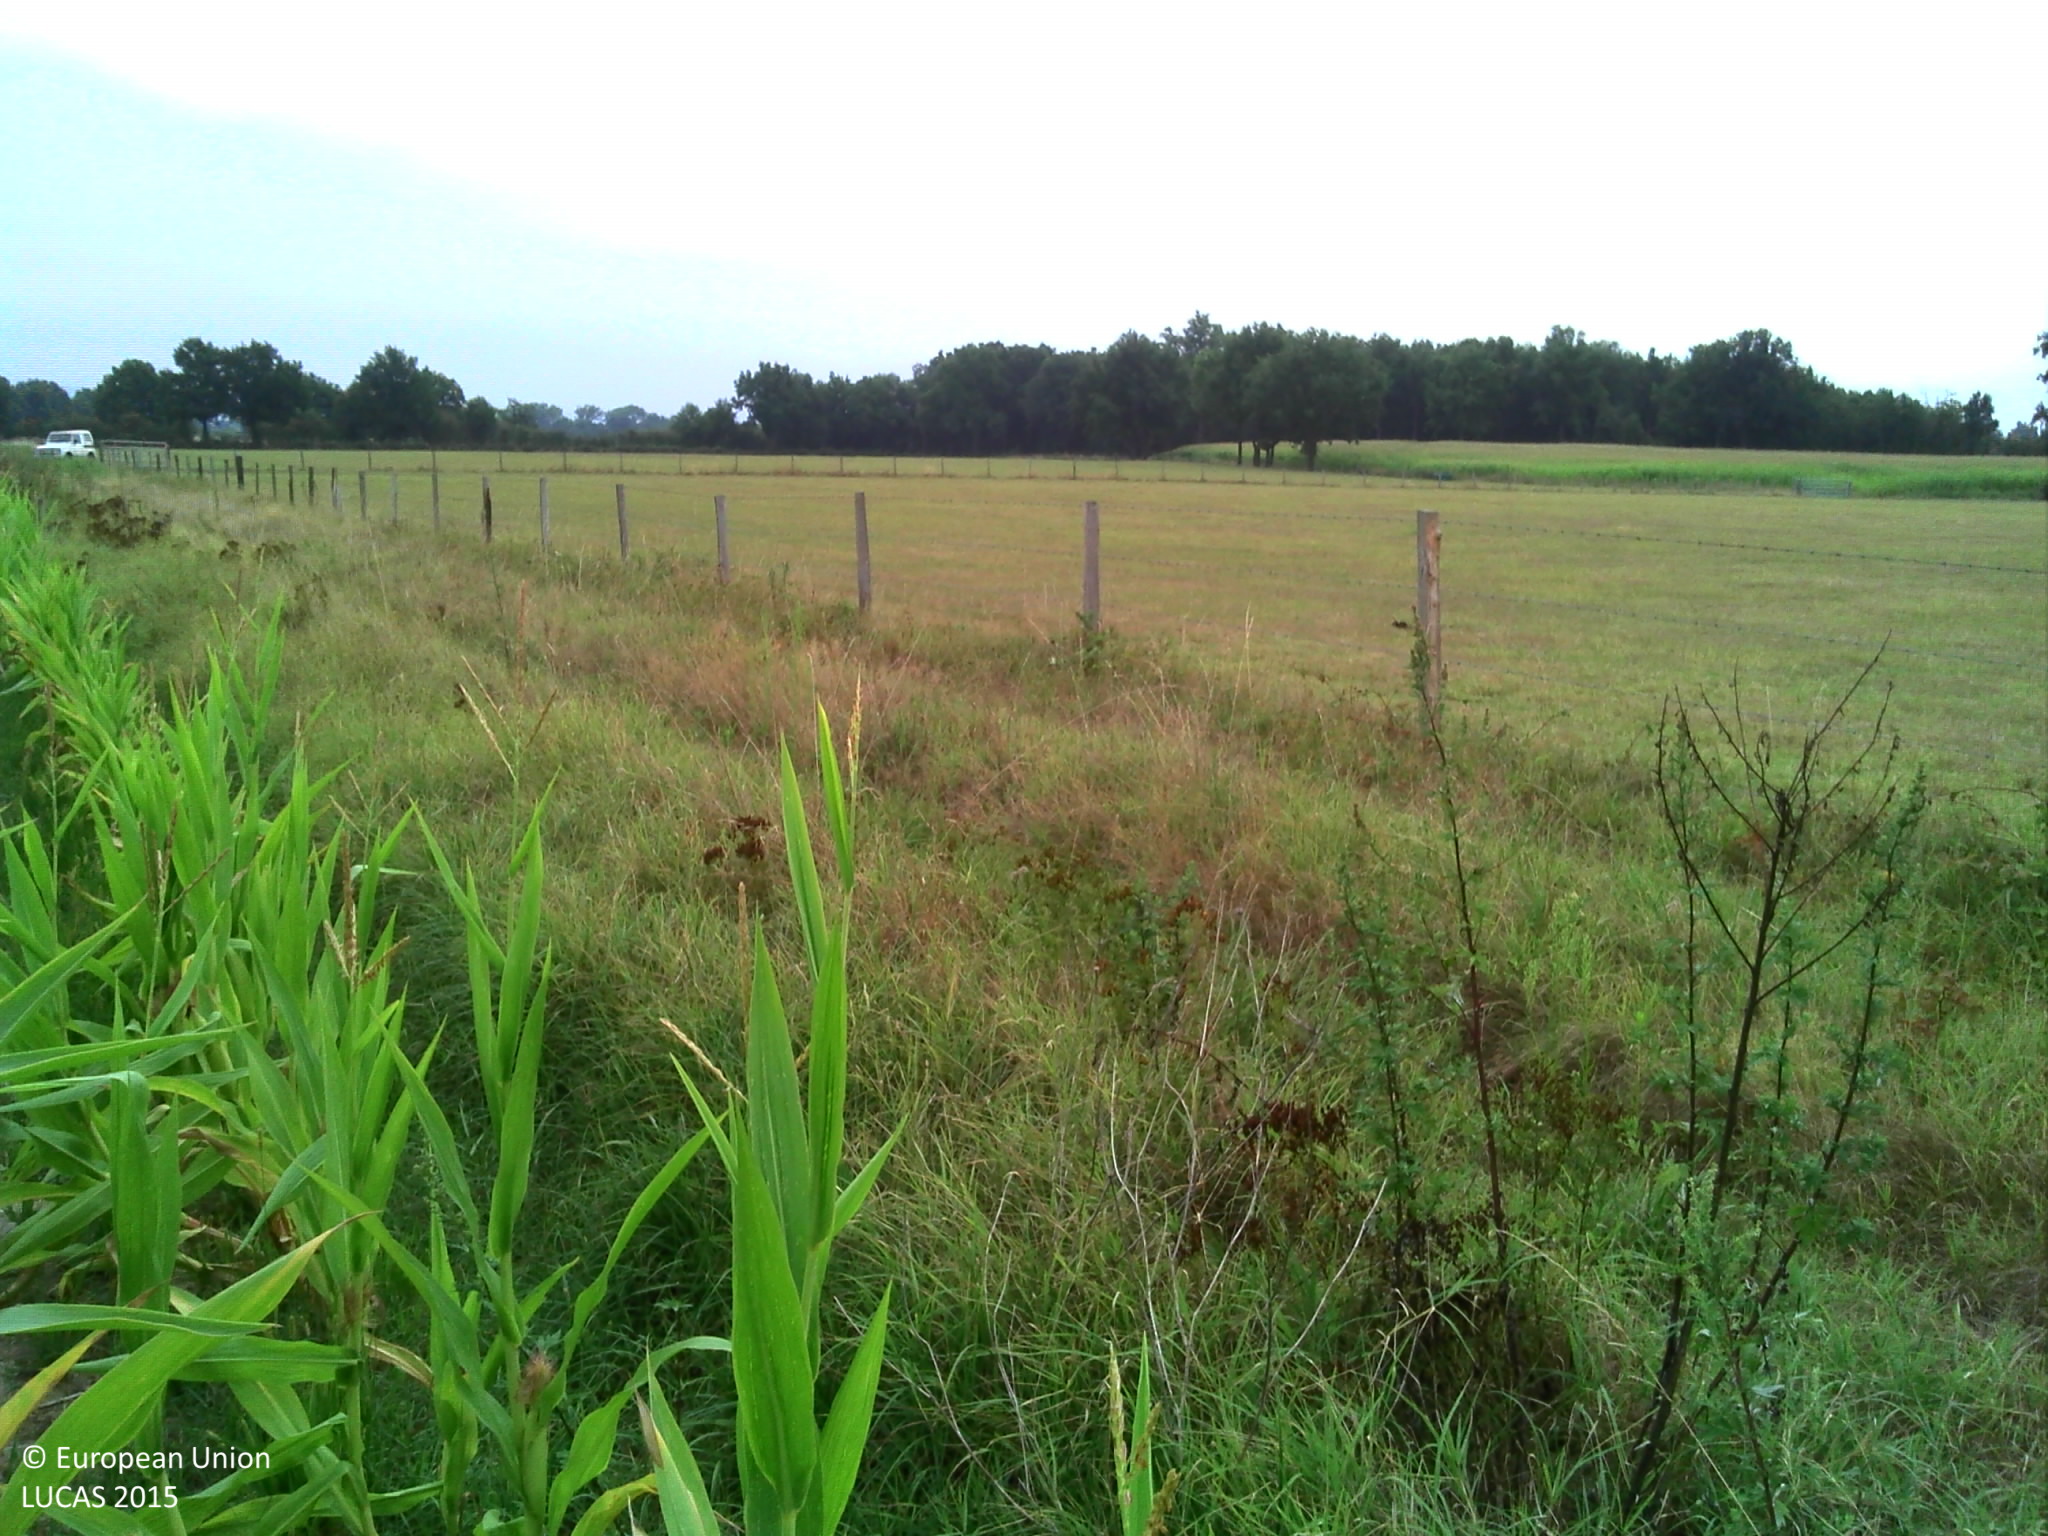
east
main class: Cropland
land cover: Maize
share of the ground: 50 - 75 %
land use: Agriculture (excluding fallow land and kitchen gardens)
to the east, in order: Maize; Electric lines; Maize
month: August
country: FR
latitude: 45.6307
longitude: 4.1408
